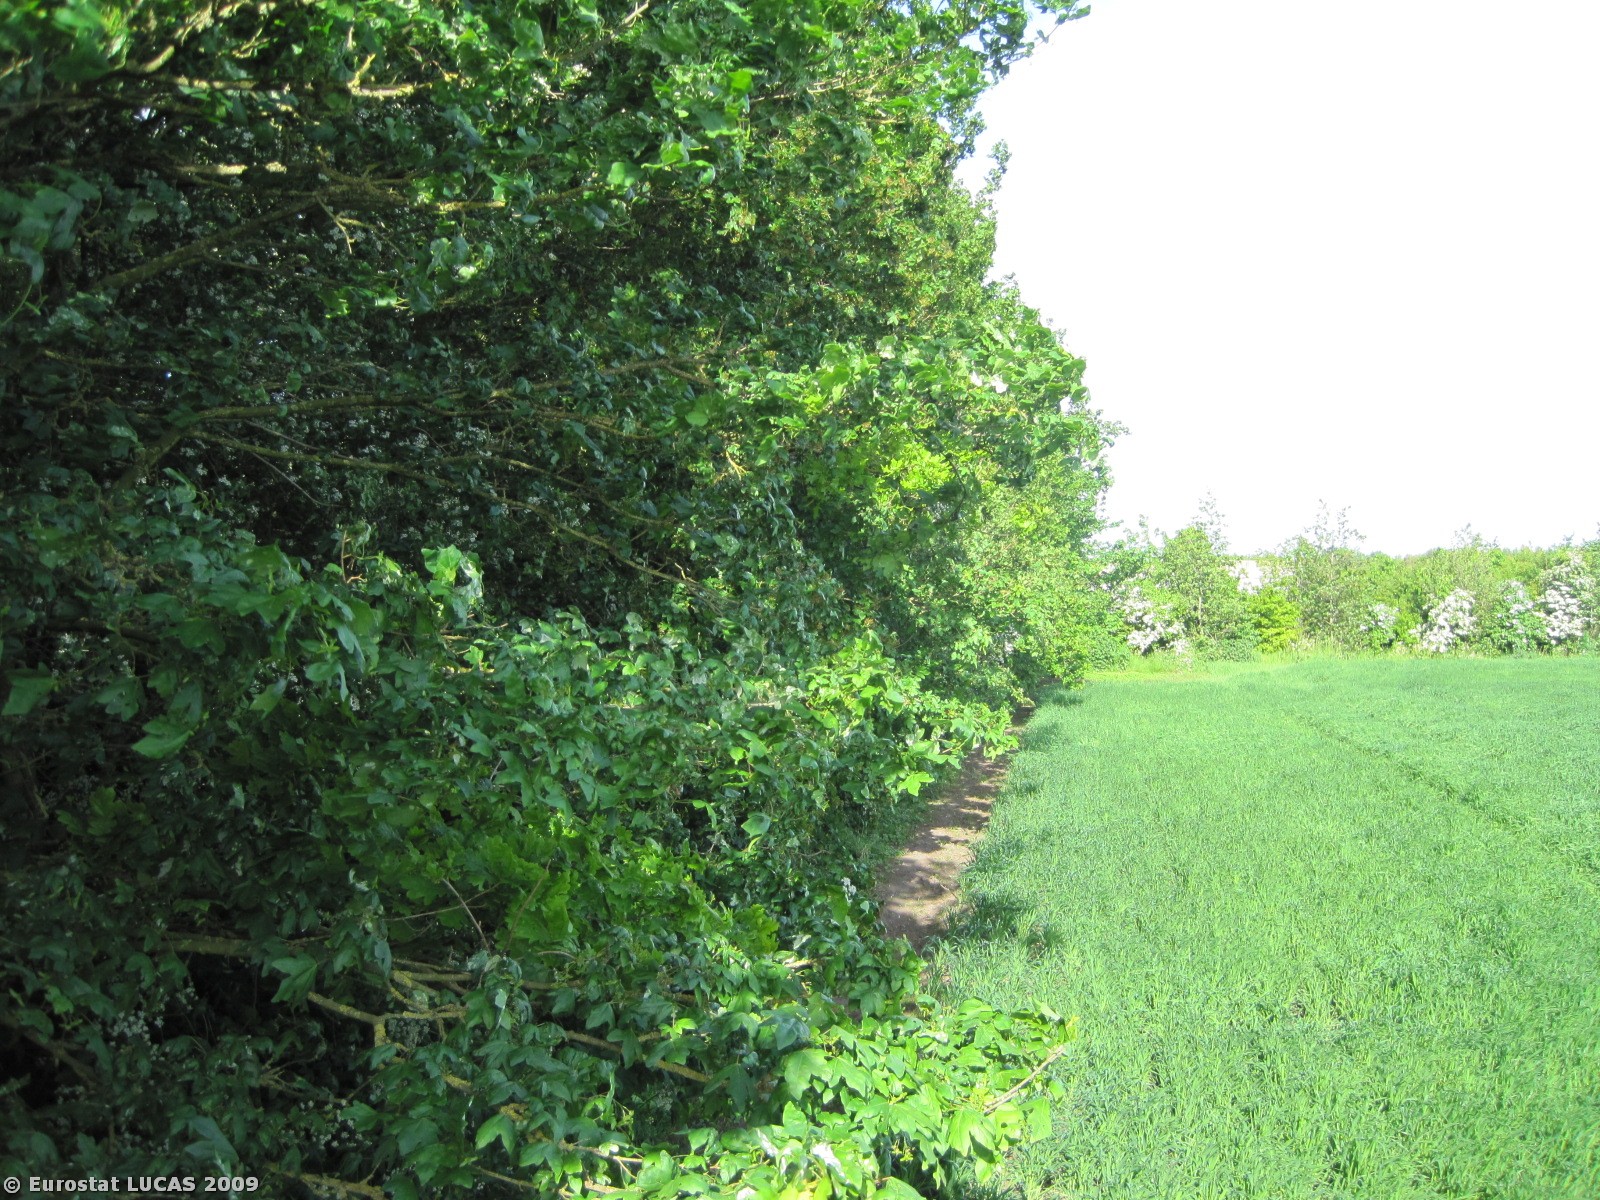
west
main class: Woodland
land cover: Broadleaved woodland
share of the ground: > 75 %
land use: Unused
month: May
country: DK
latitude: 56.5832
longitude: 10.0813
